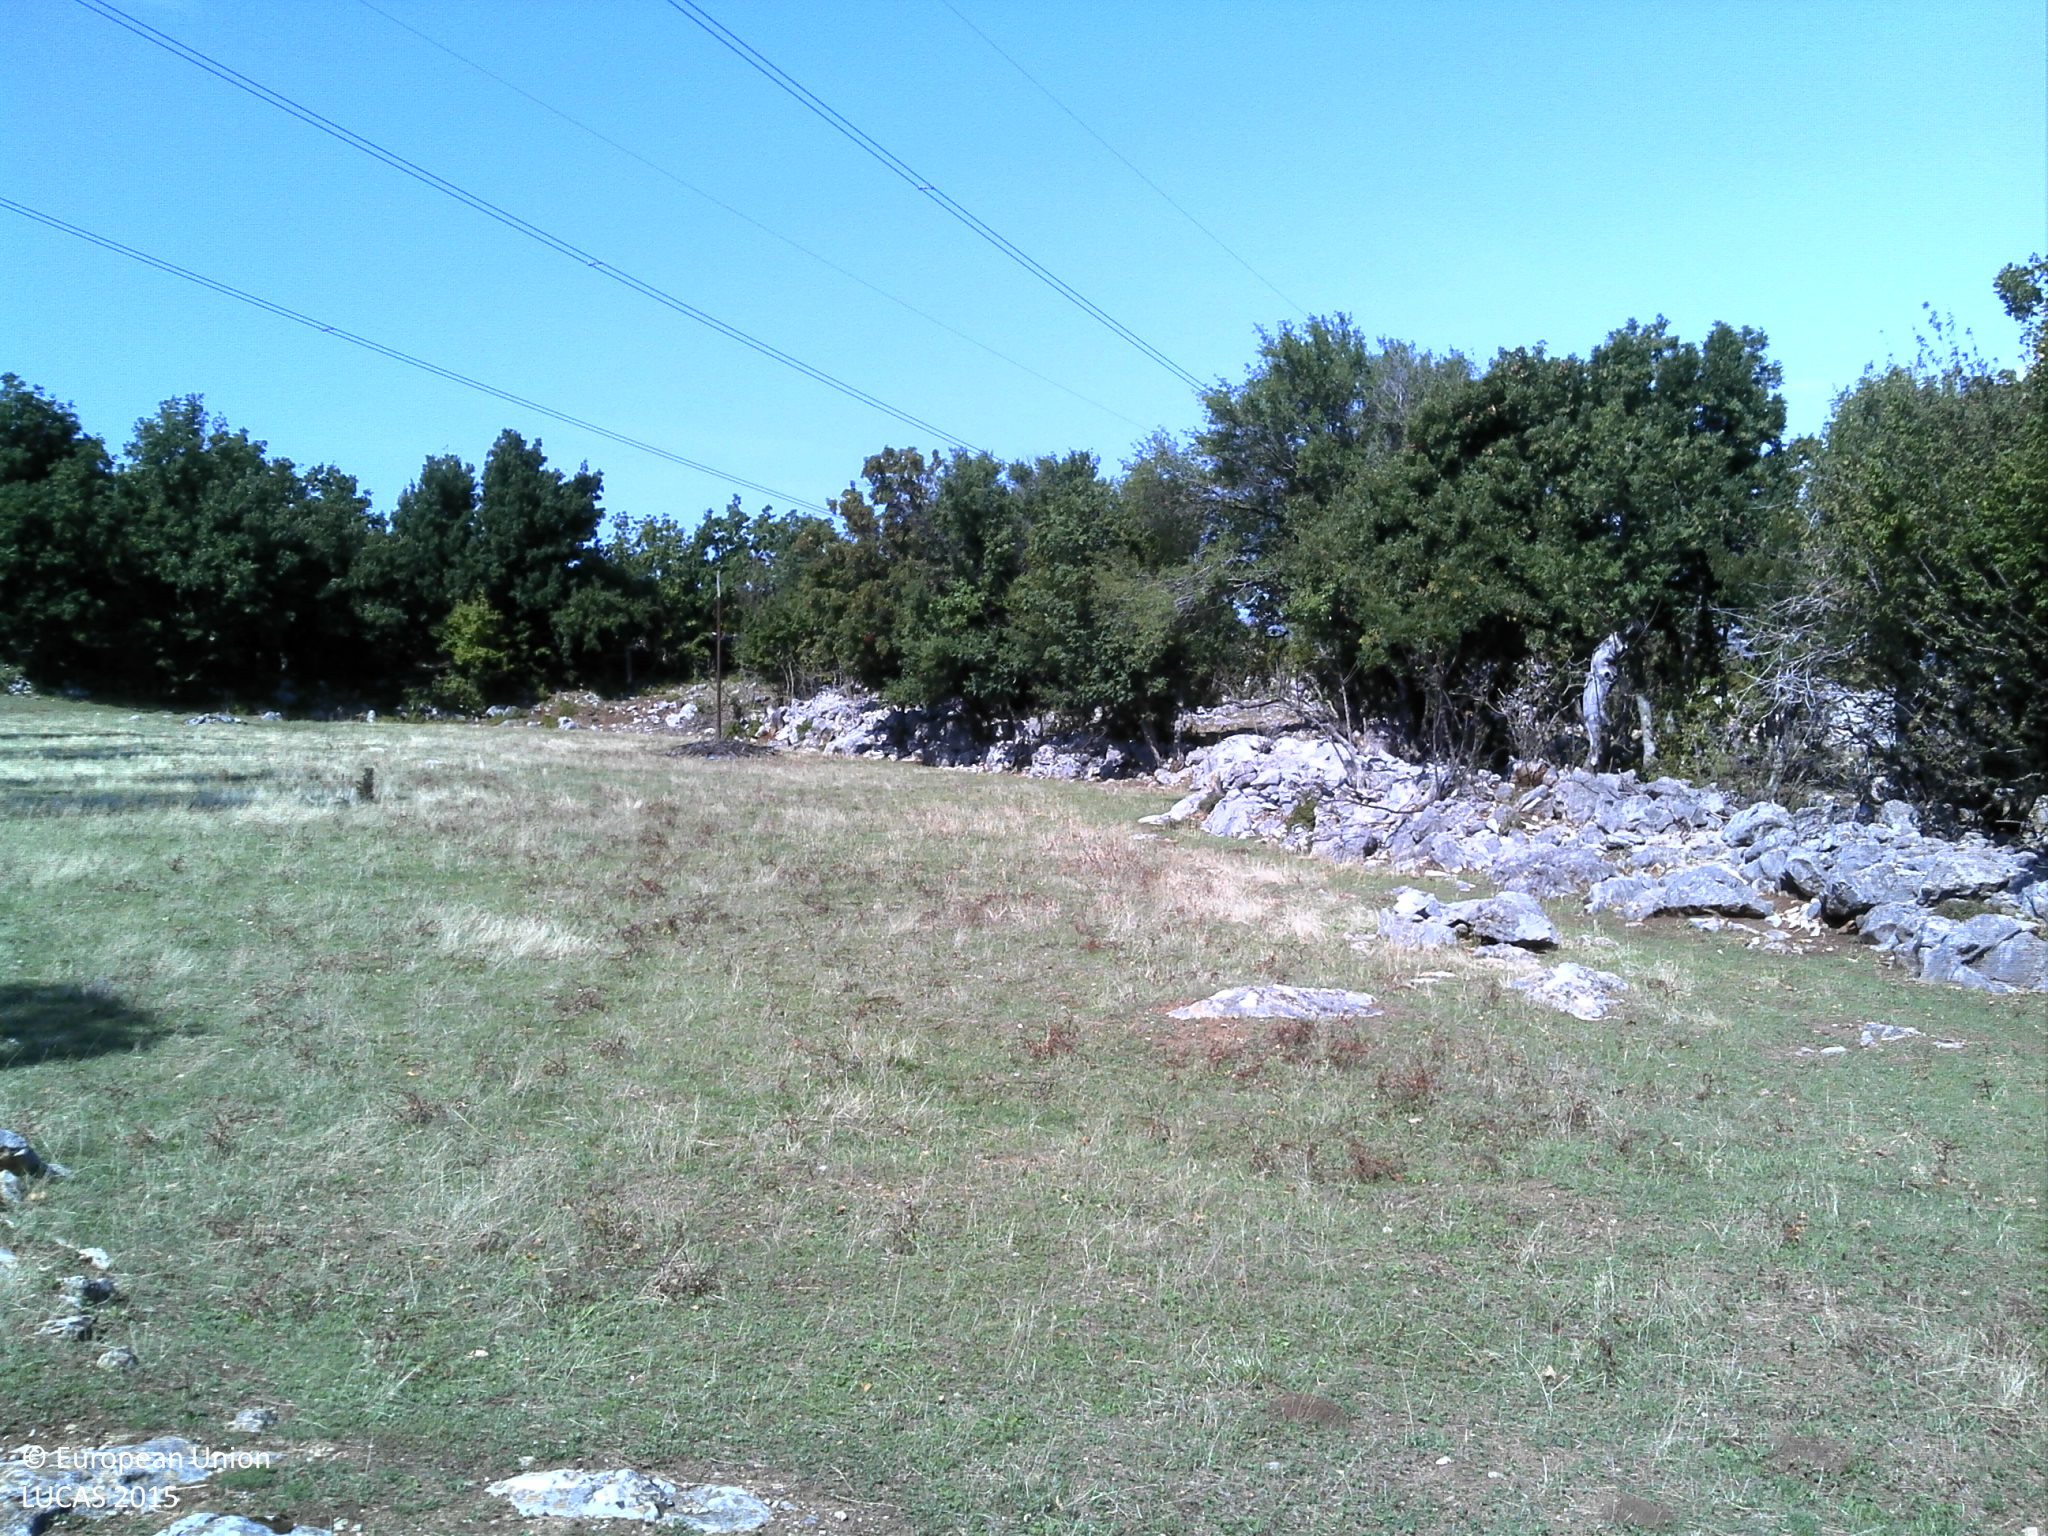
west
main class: Grassland
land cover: Grassland with sparse tree/shrub cover
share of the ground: 50 - 75 %
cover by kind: herbaceous plants 75 %, shrubs 10 %, broadleaved forest trees 5 %, consolidated bare surface 5 %, unconsolidated bare surface 5 %
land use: Agriculture (excluding fallow land and kitchen gardens)
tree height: > 5 m
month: August
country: HR
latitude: 44.2043
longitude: 15.8367
